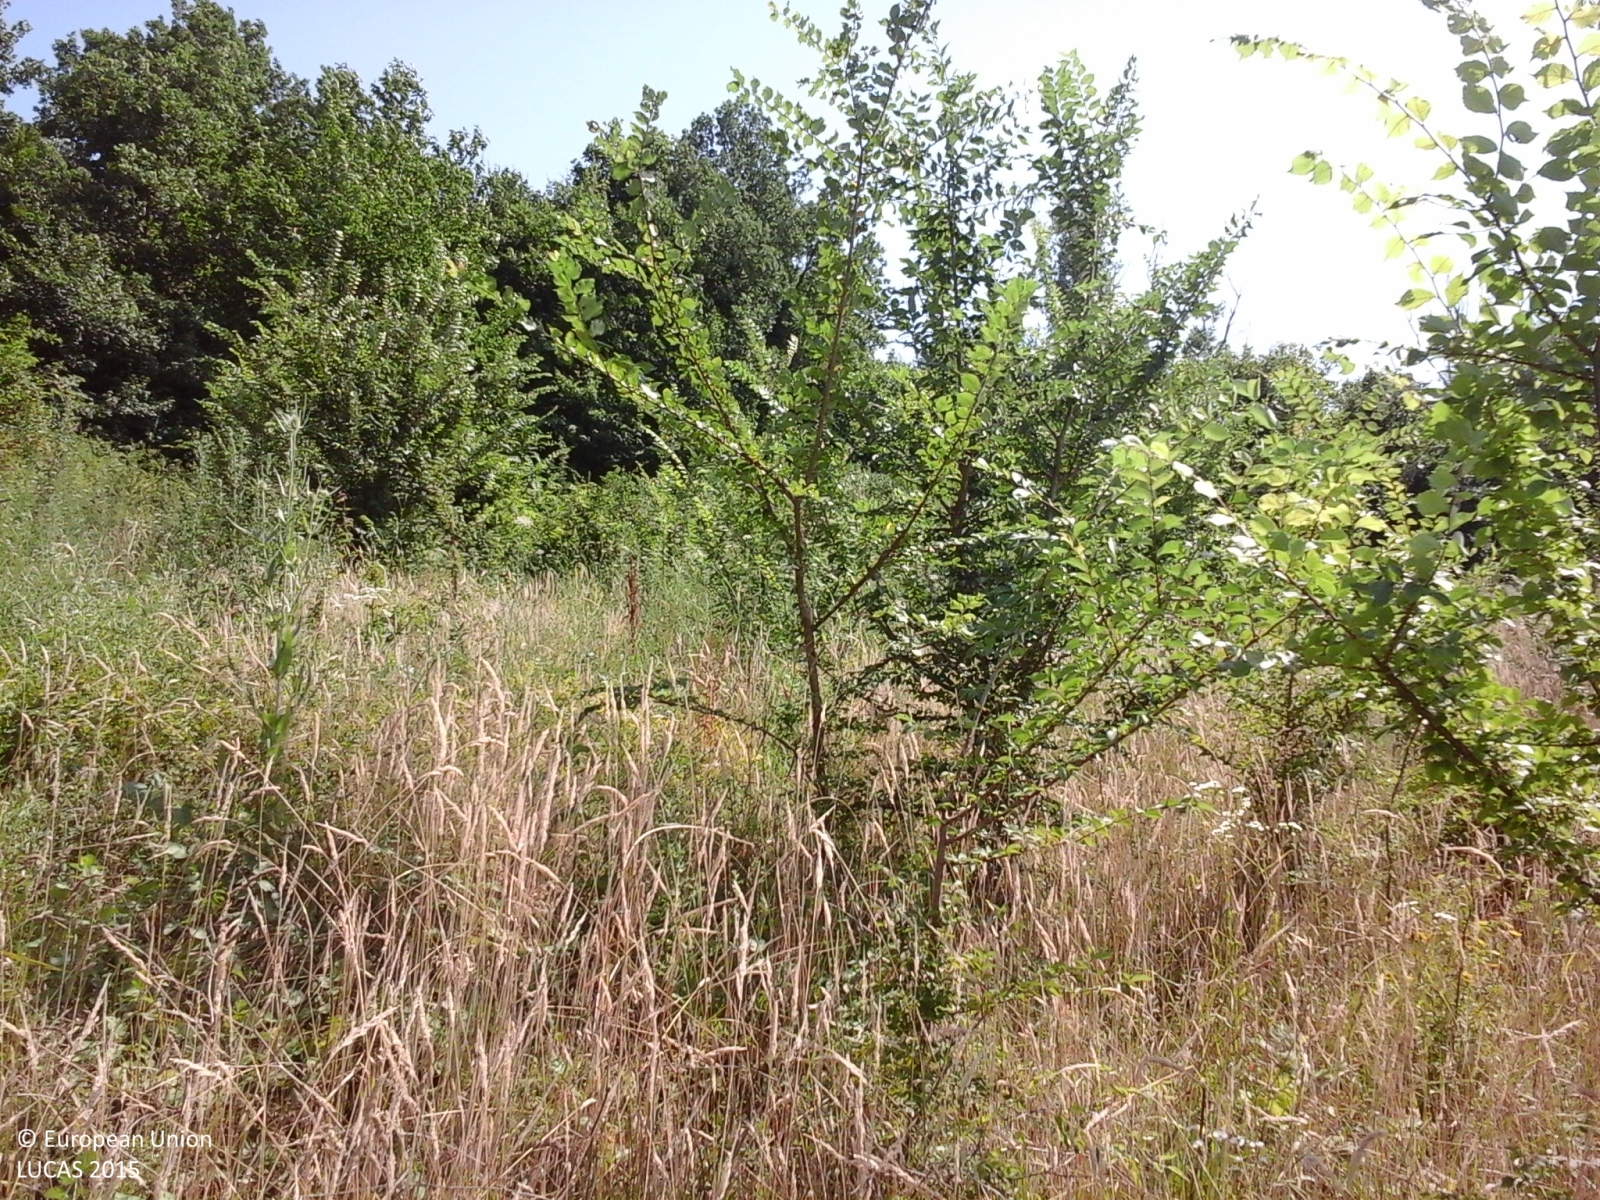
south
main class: Grassland
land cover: Grassland with sparse tree/shrub cover
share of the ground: > 75 %
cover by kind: herbaceous plants 95 %, broadleaved forest trees 5 %
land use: Abandoned areas
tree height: < 5 m
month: July
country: IT
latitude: 43.0875
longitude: 13.3199
